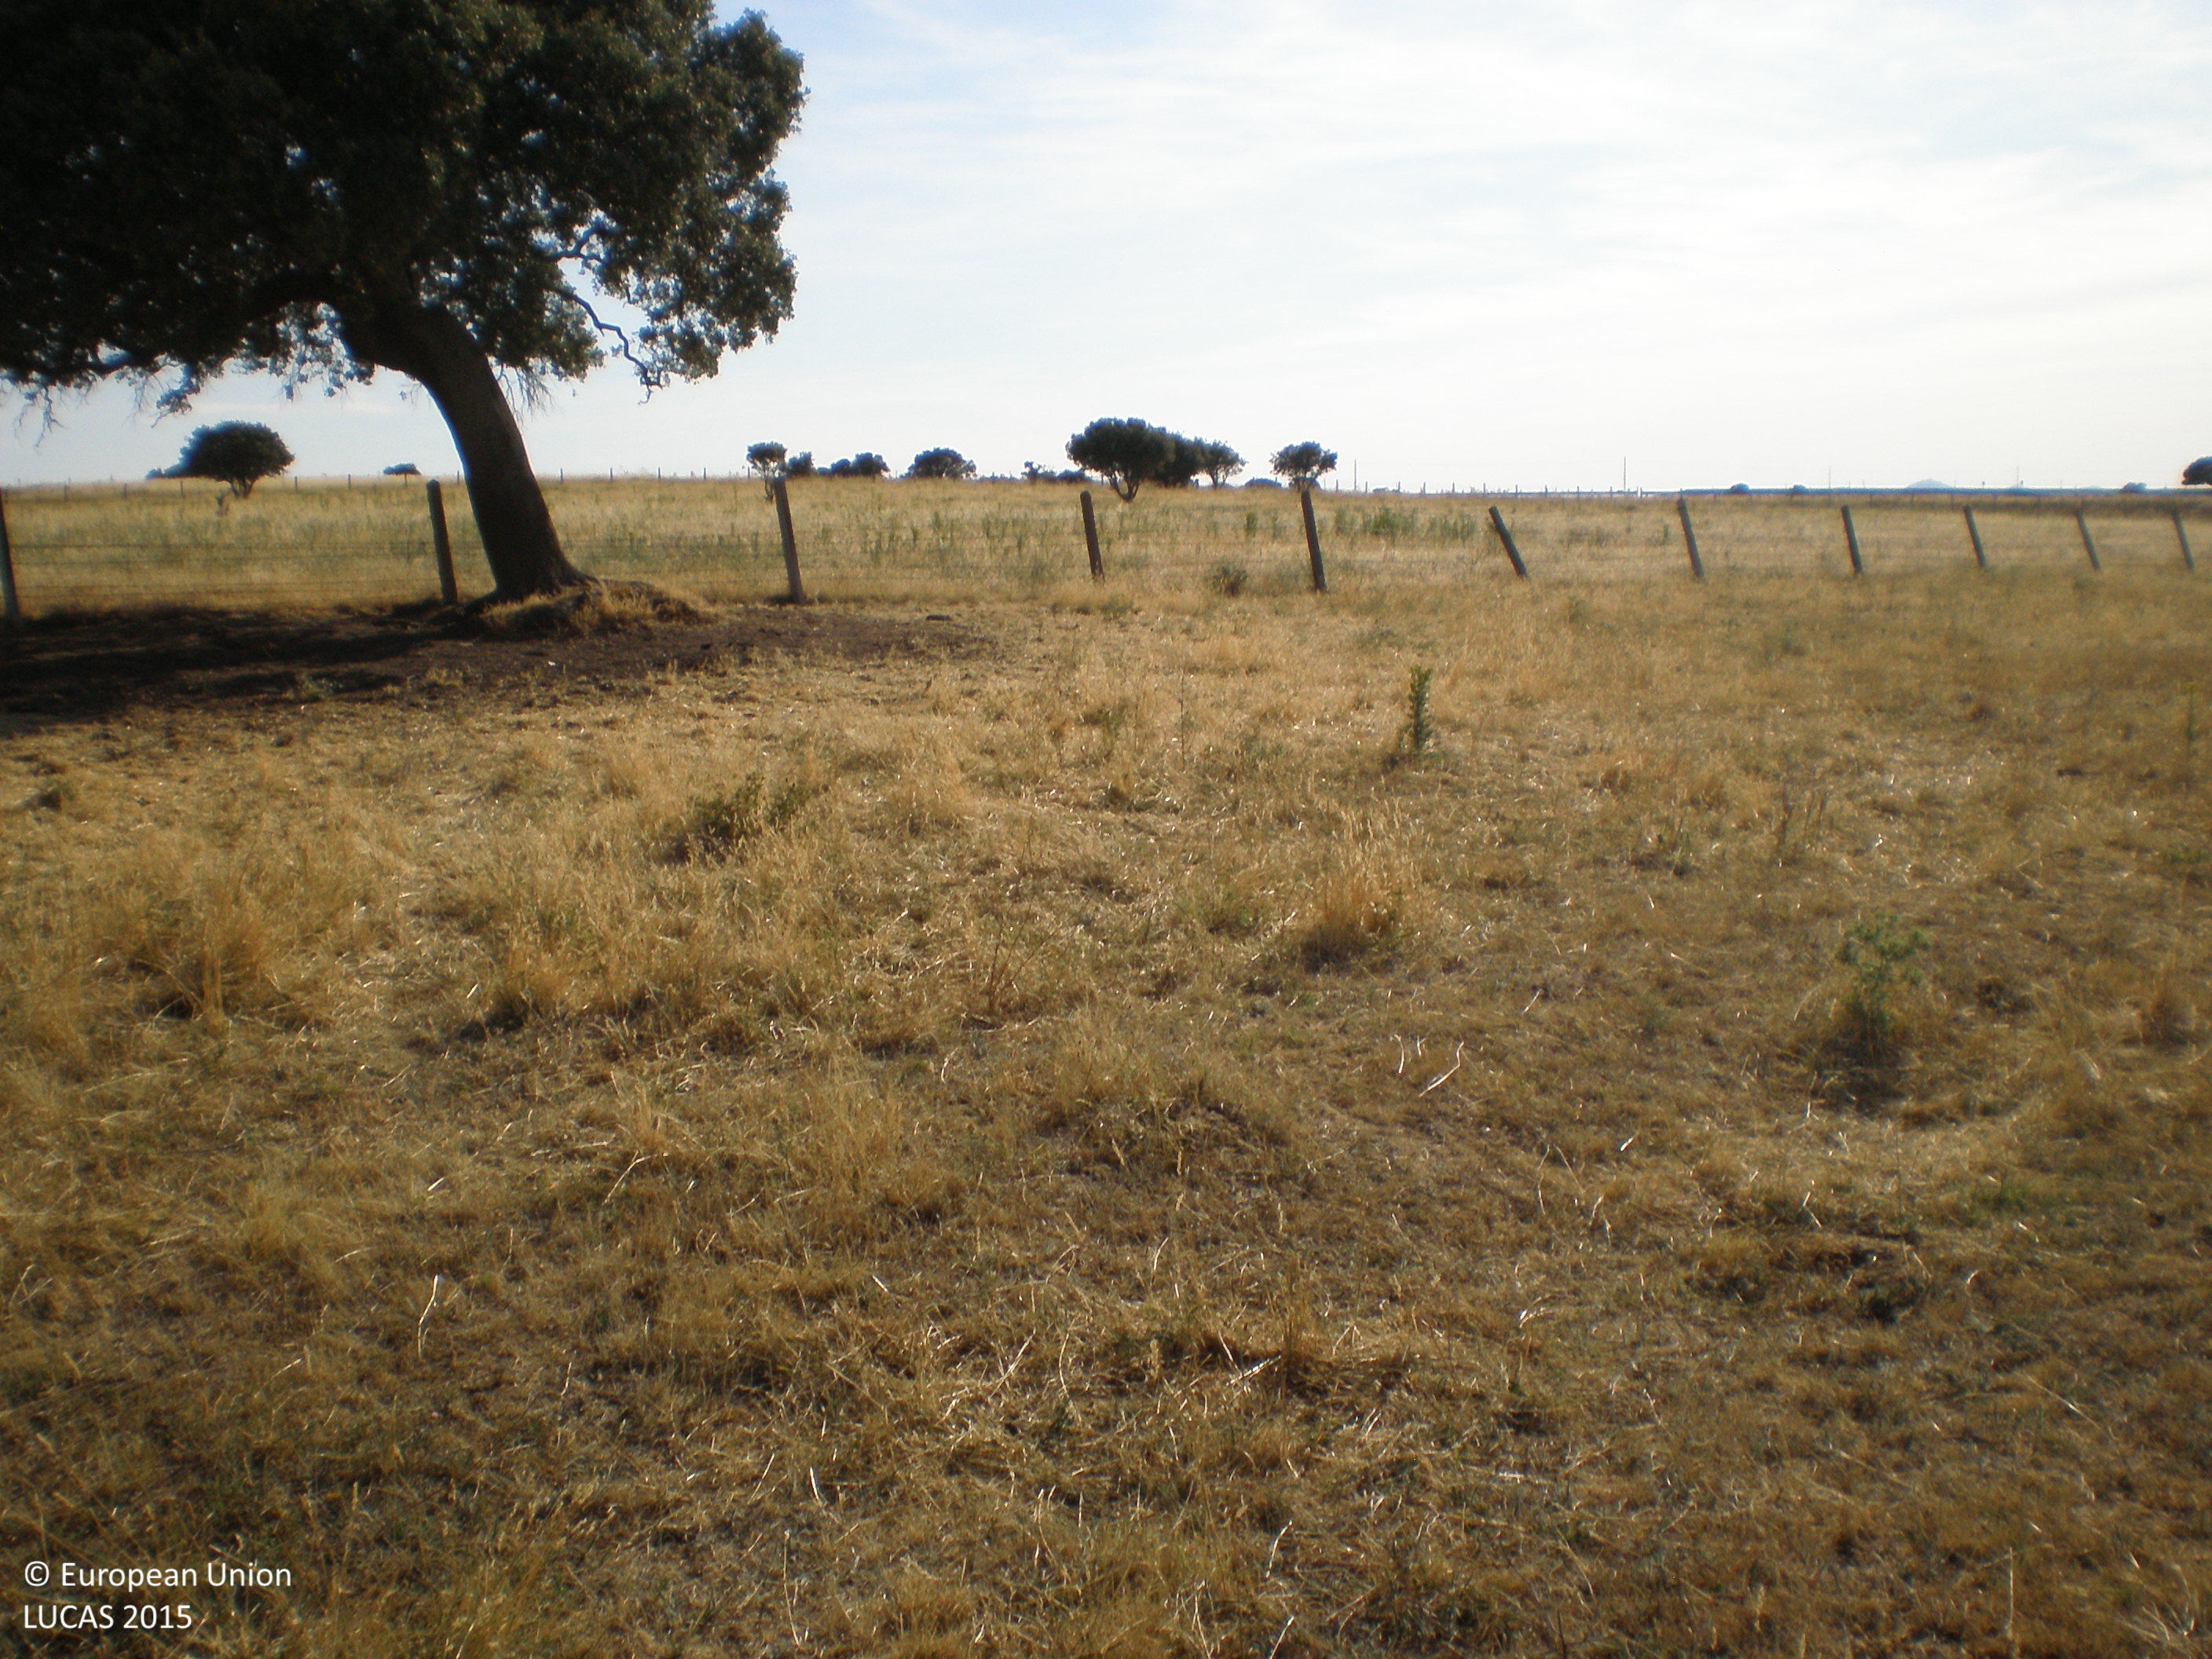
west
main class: Grassland
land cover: Grassland without tree/shrub cover
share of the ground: > 75 %
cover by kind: herbaceous plants 100 %
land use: Agriculture (excluding fallow land and kitchen gardens)
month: July
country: ES
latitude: 40.5830
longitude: -5.6546
